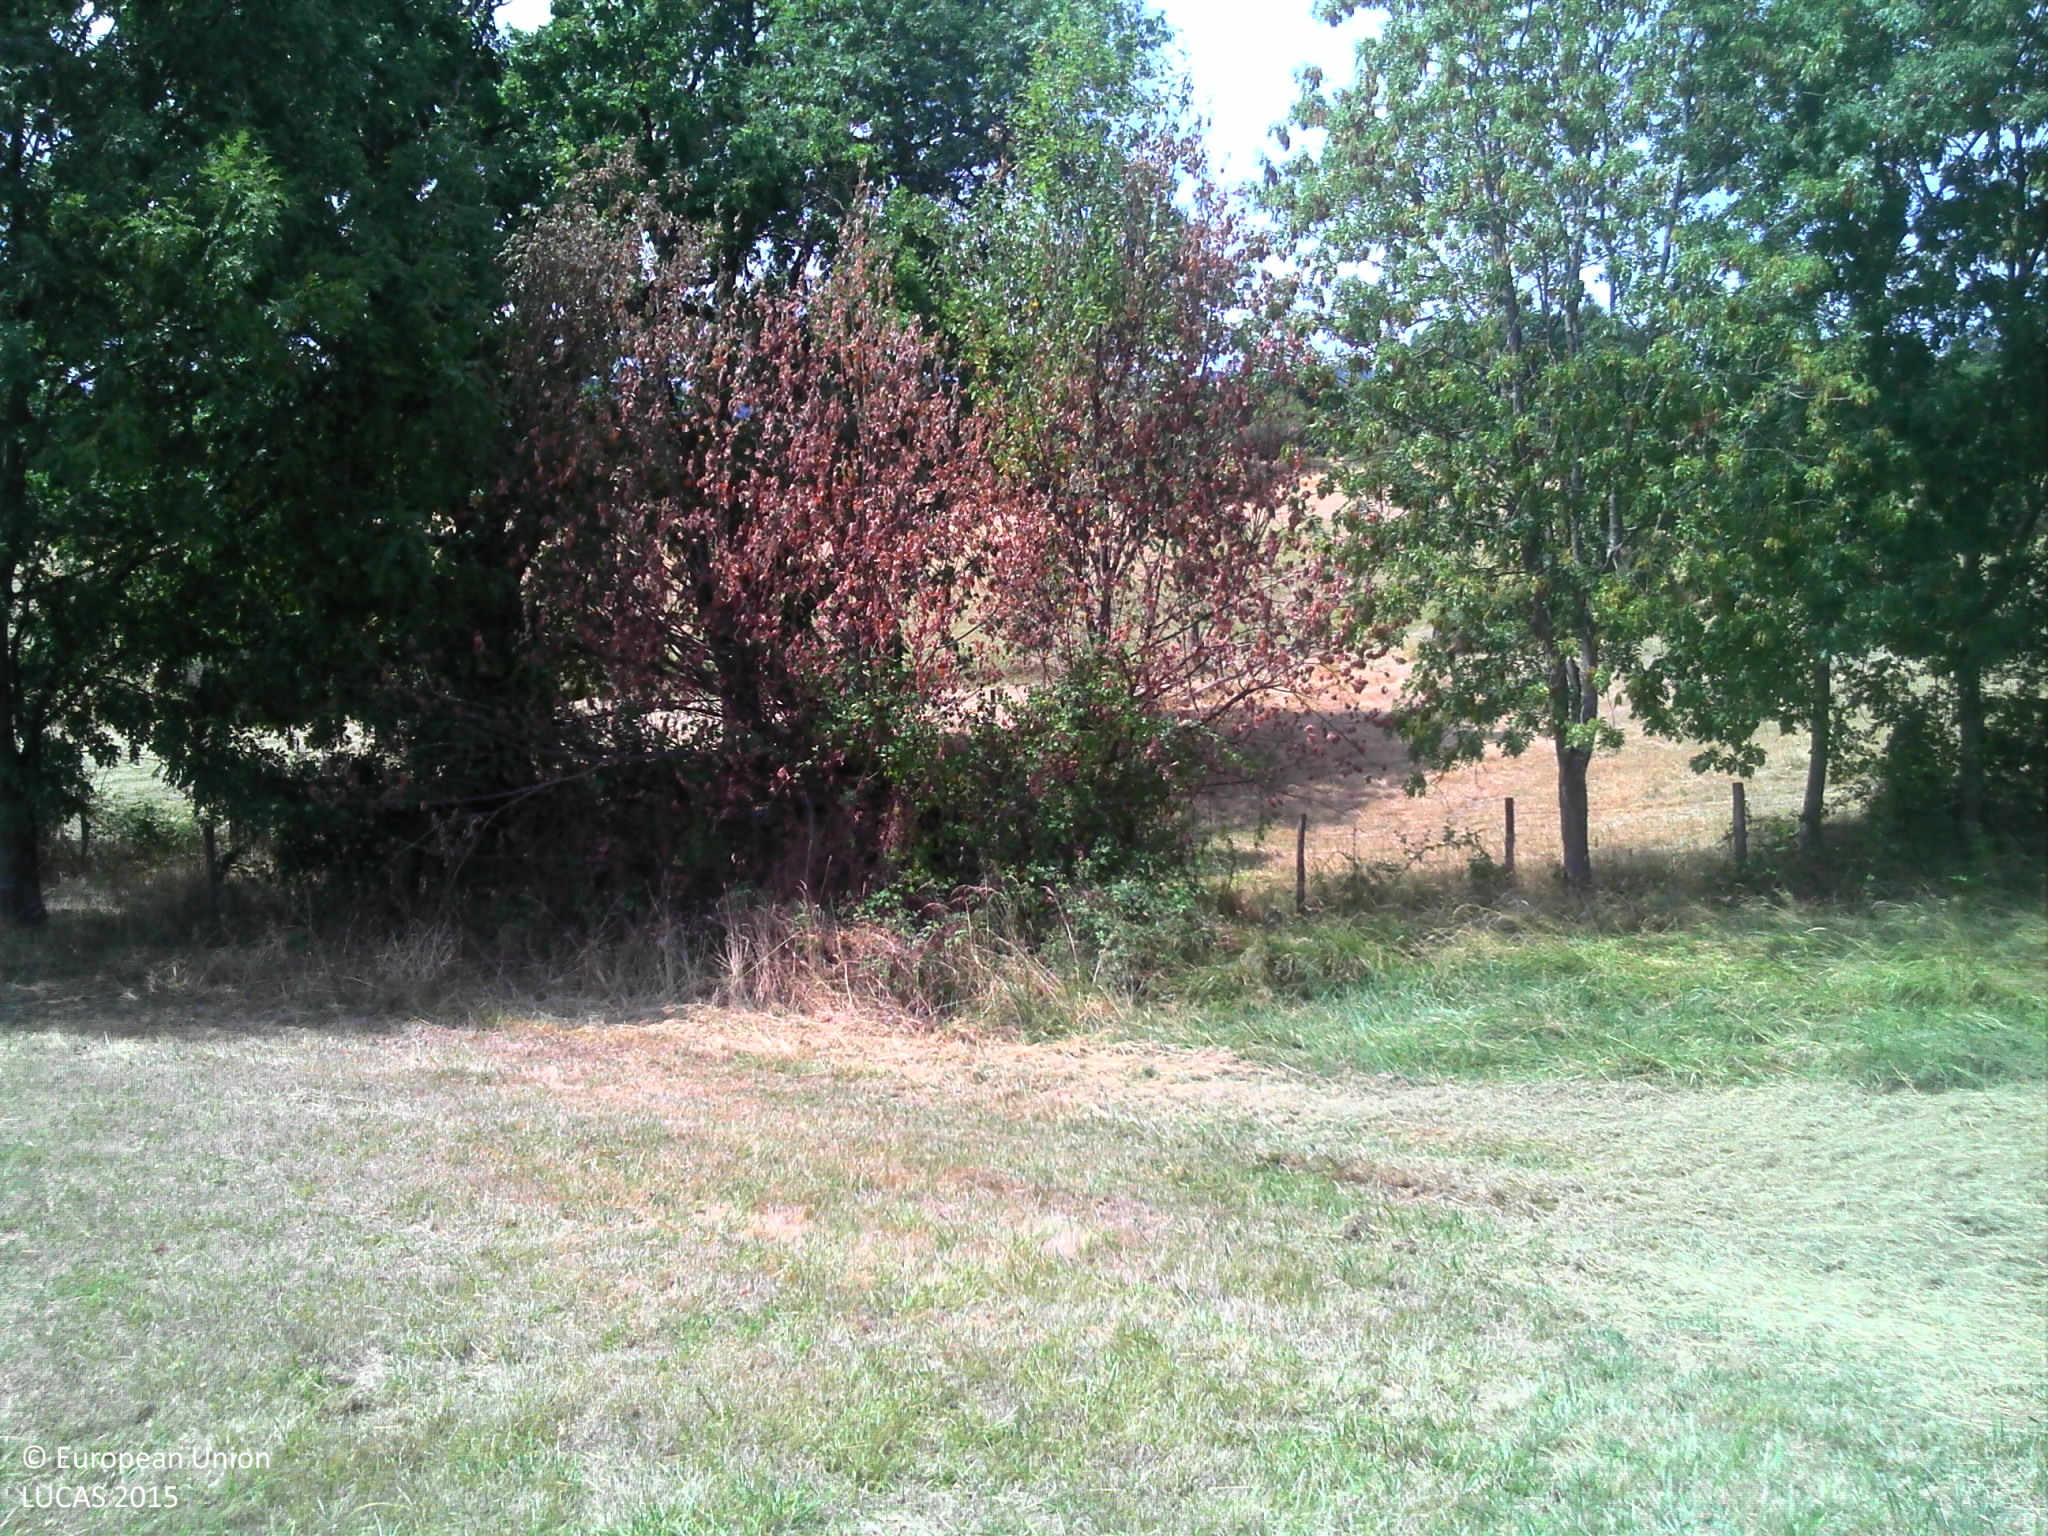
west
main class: Grassland
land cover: Grassland without tree/shrub cover
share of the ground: > 75 %
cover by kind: herbaceous plants 100 %
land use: Agriculture (excluding fallow land and kitchen gardens)
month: August
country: FR
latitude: 45.7682
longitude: 4.6927
